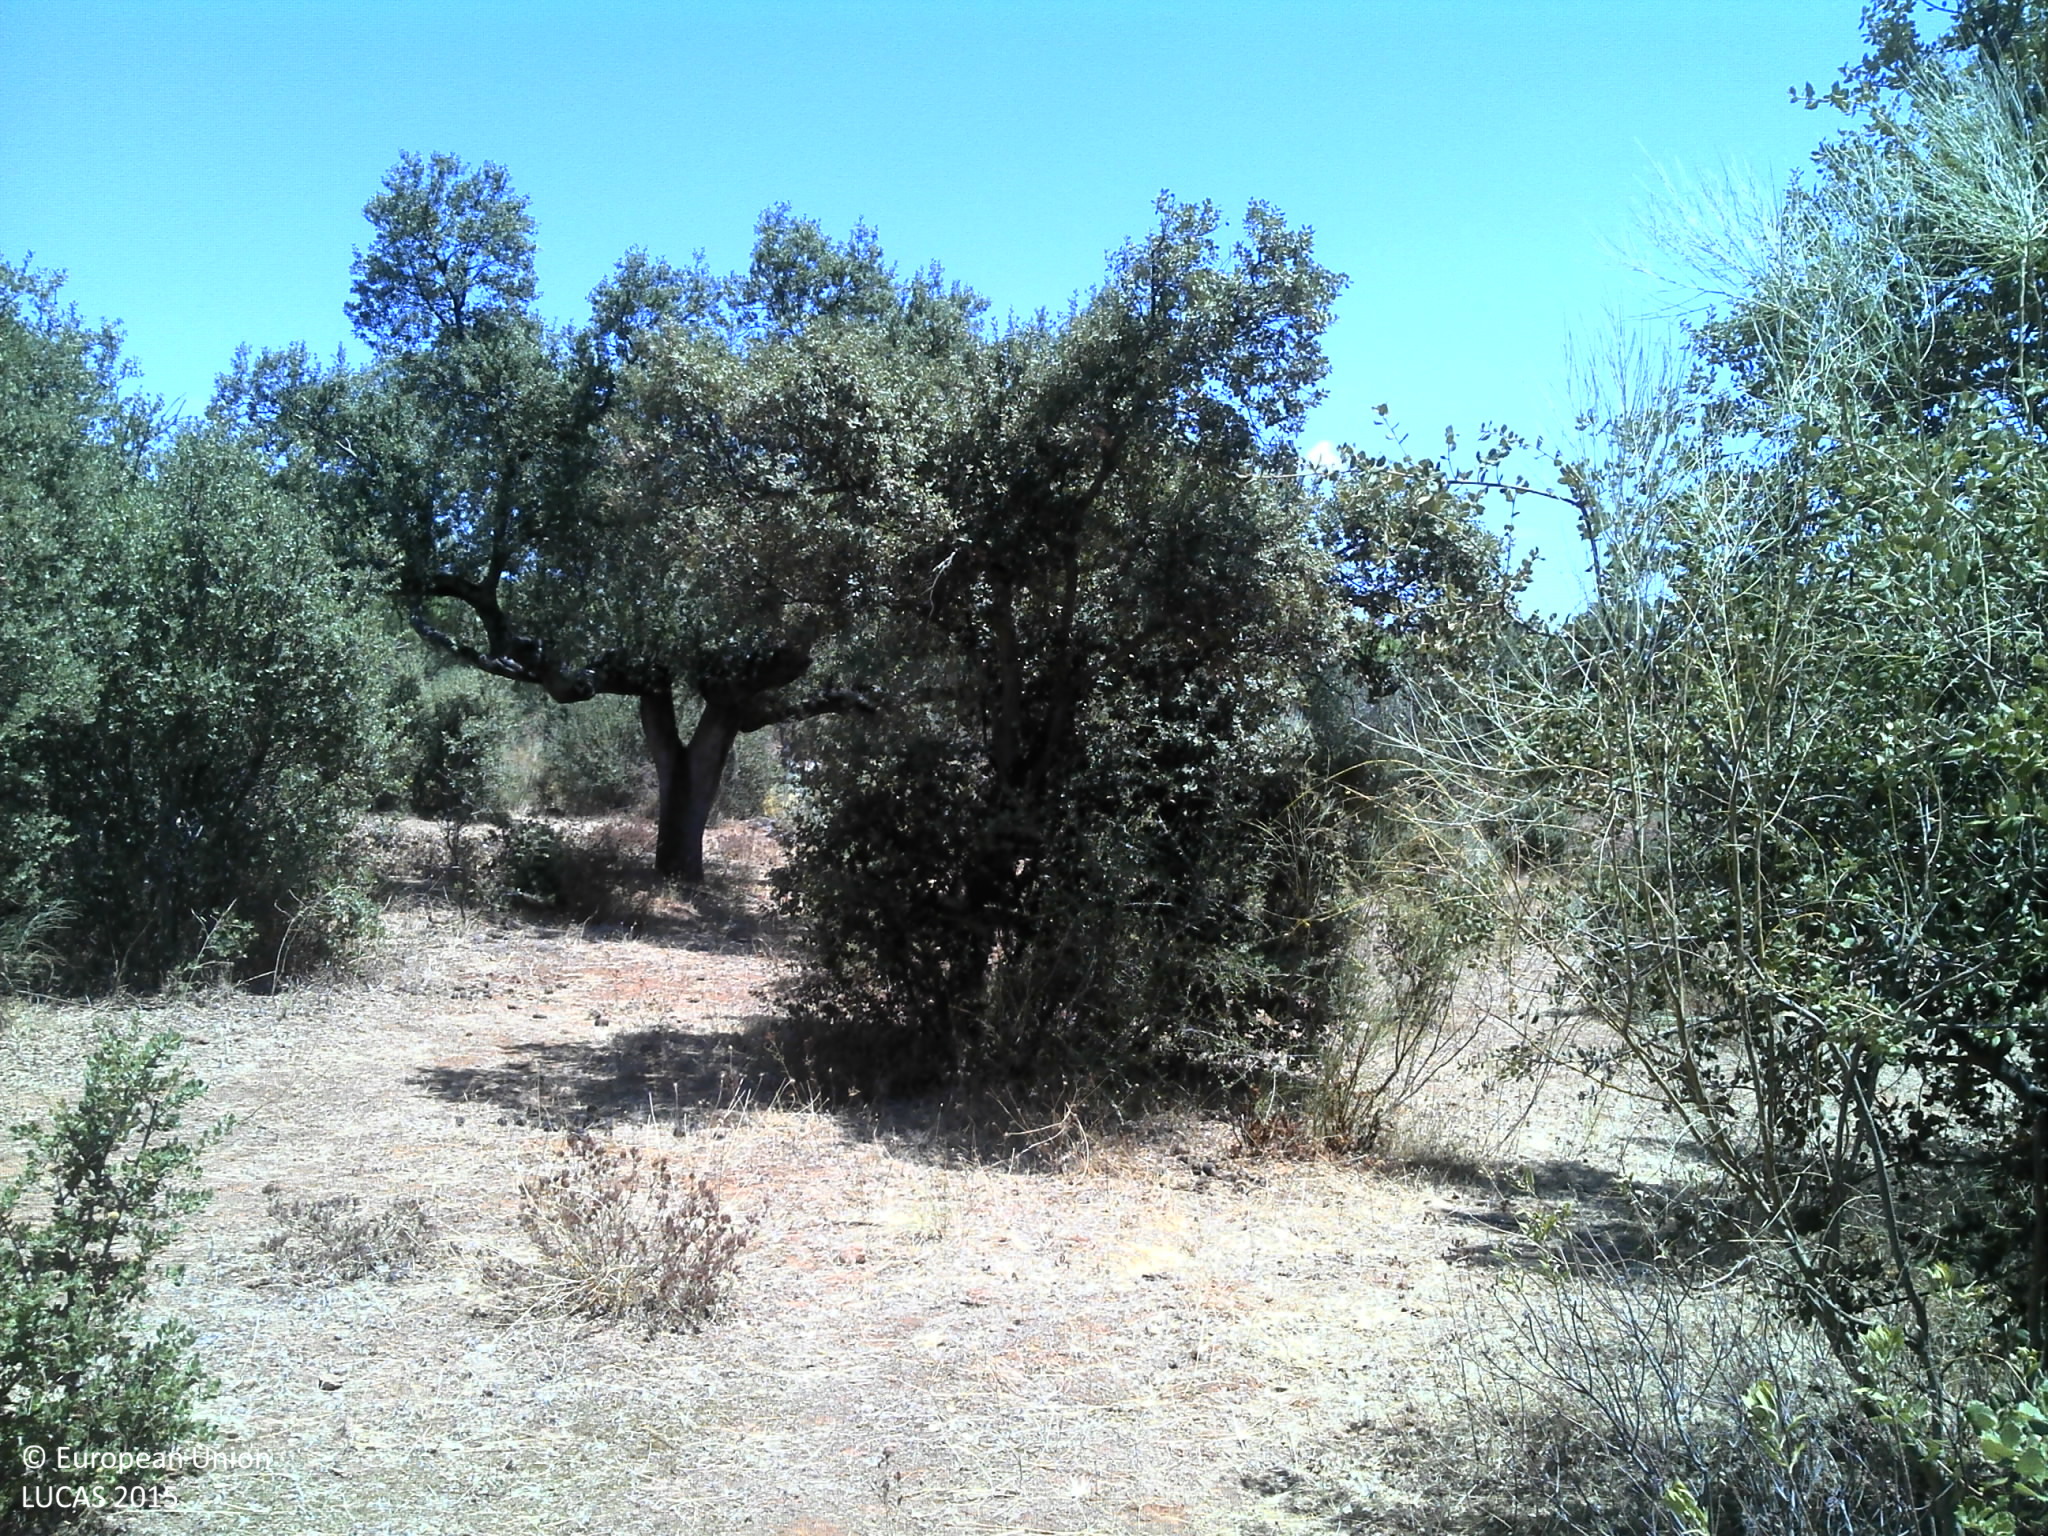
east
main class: Woodland
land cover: Broadleaved woodland
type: broadleaved evergreen forest
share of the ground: 25 - 50 %
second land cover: Shrubland without tree cover
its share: 50 - 75 %
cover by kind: shrubs 50 %, broadleaved forest trees 30 %, unconsolidated bare surface 20 %
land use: Forestry
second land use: Agriculture (excluding fallow land and kitchen gardens)
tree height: > 5 m
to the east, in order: Broadleaved woodland; Shrubland without tree cover; Broadleaved woodland; Fences; Broadleaved woodland; Fences; Grass margins; Electric lines; Grass margins; Tracks; Grass margins; Fences; Broadleaved woodland; Olive groves; Broadleaved woodland
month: July
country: PT
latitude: 38.8367
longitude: -7.2519
